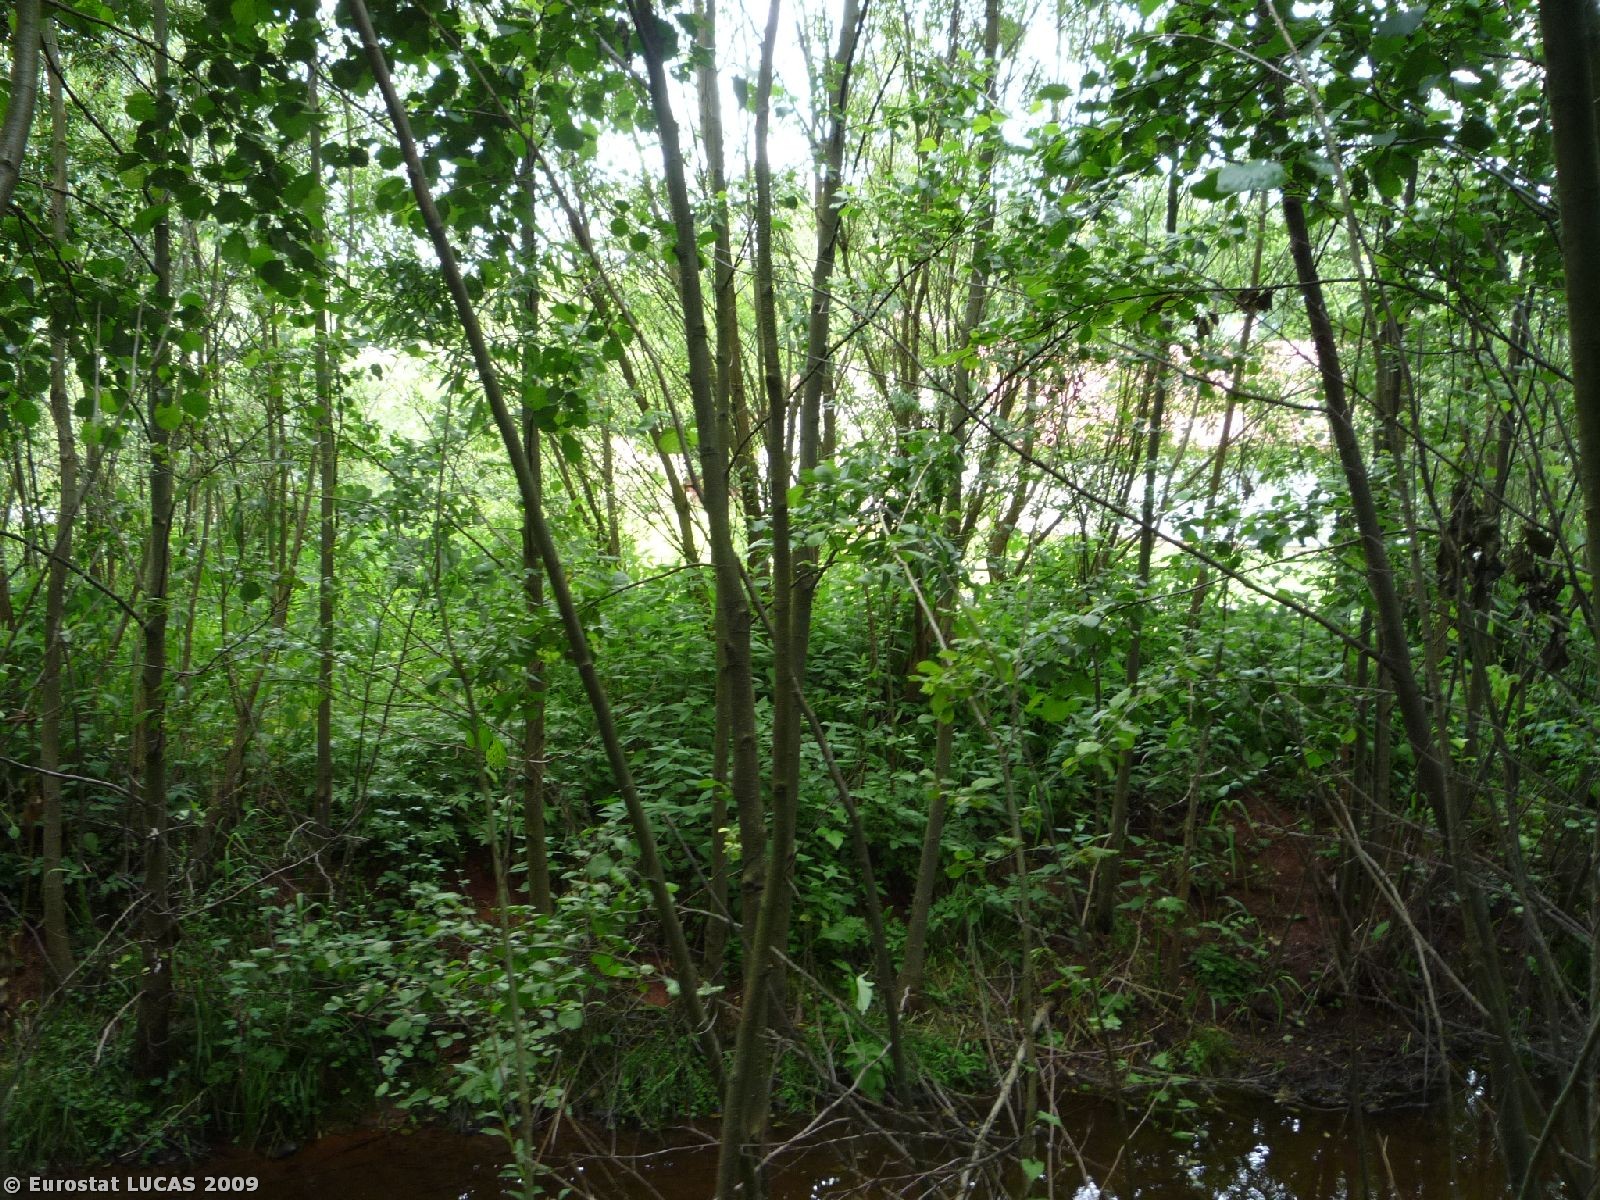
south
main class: Woodland
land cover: Broadleaved woodland
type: floodplain forest
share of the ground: > 75 %
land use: Unused
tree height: > 5 m
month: June
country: CZ
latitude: 50.5398
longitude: 15.8327
